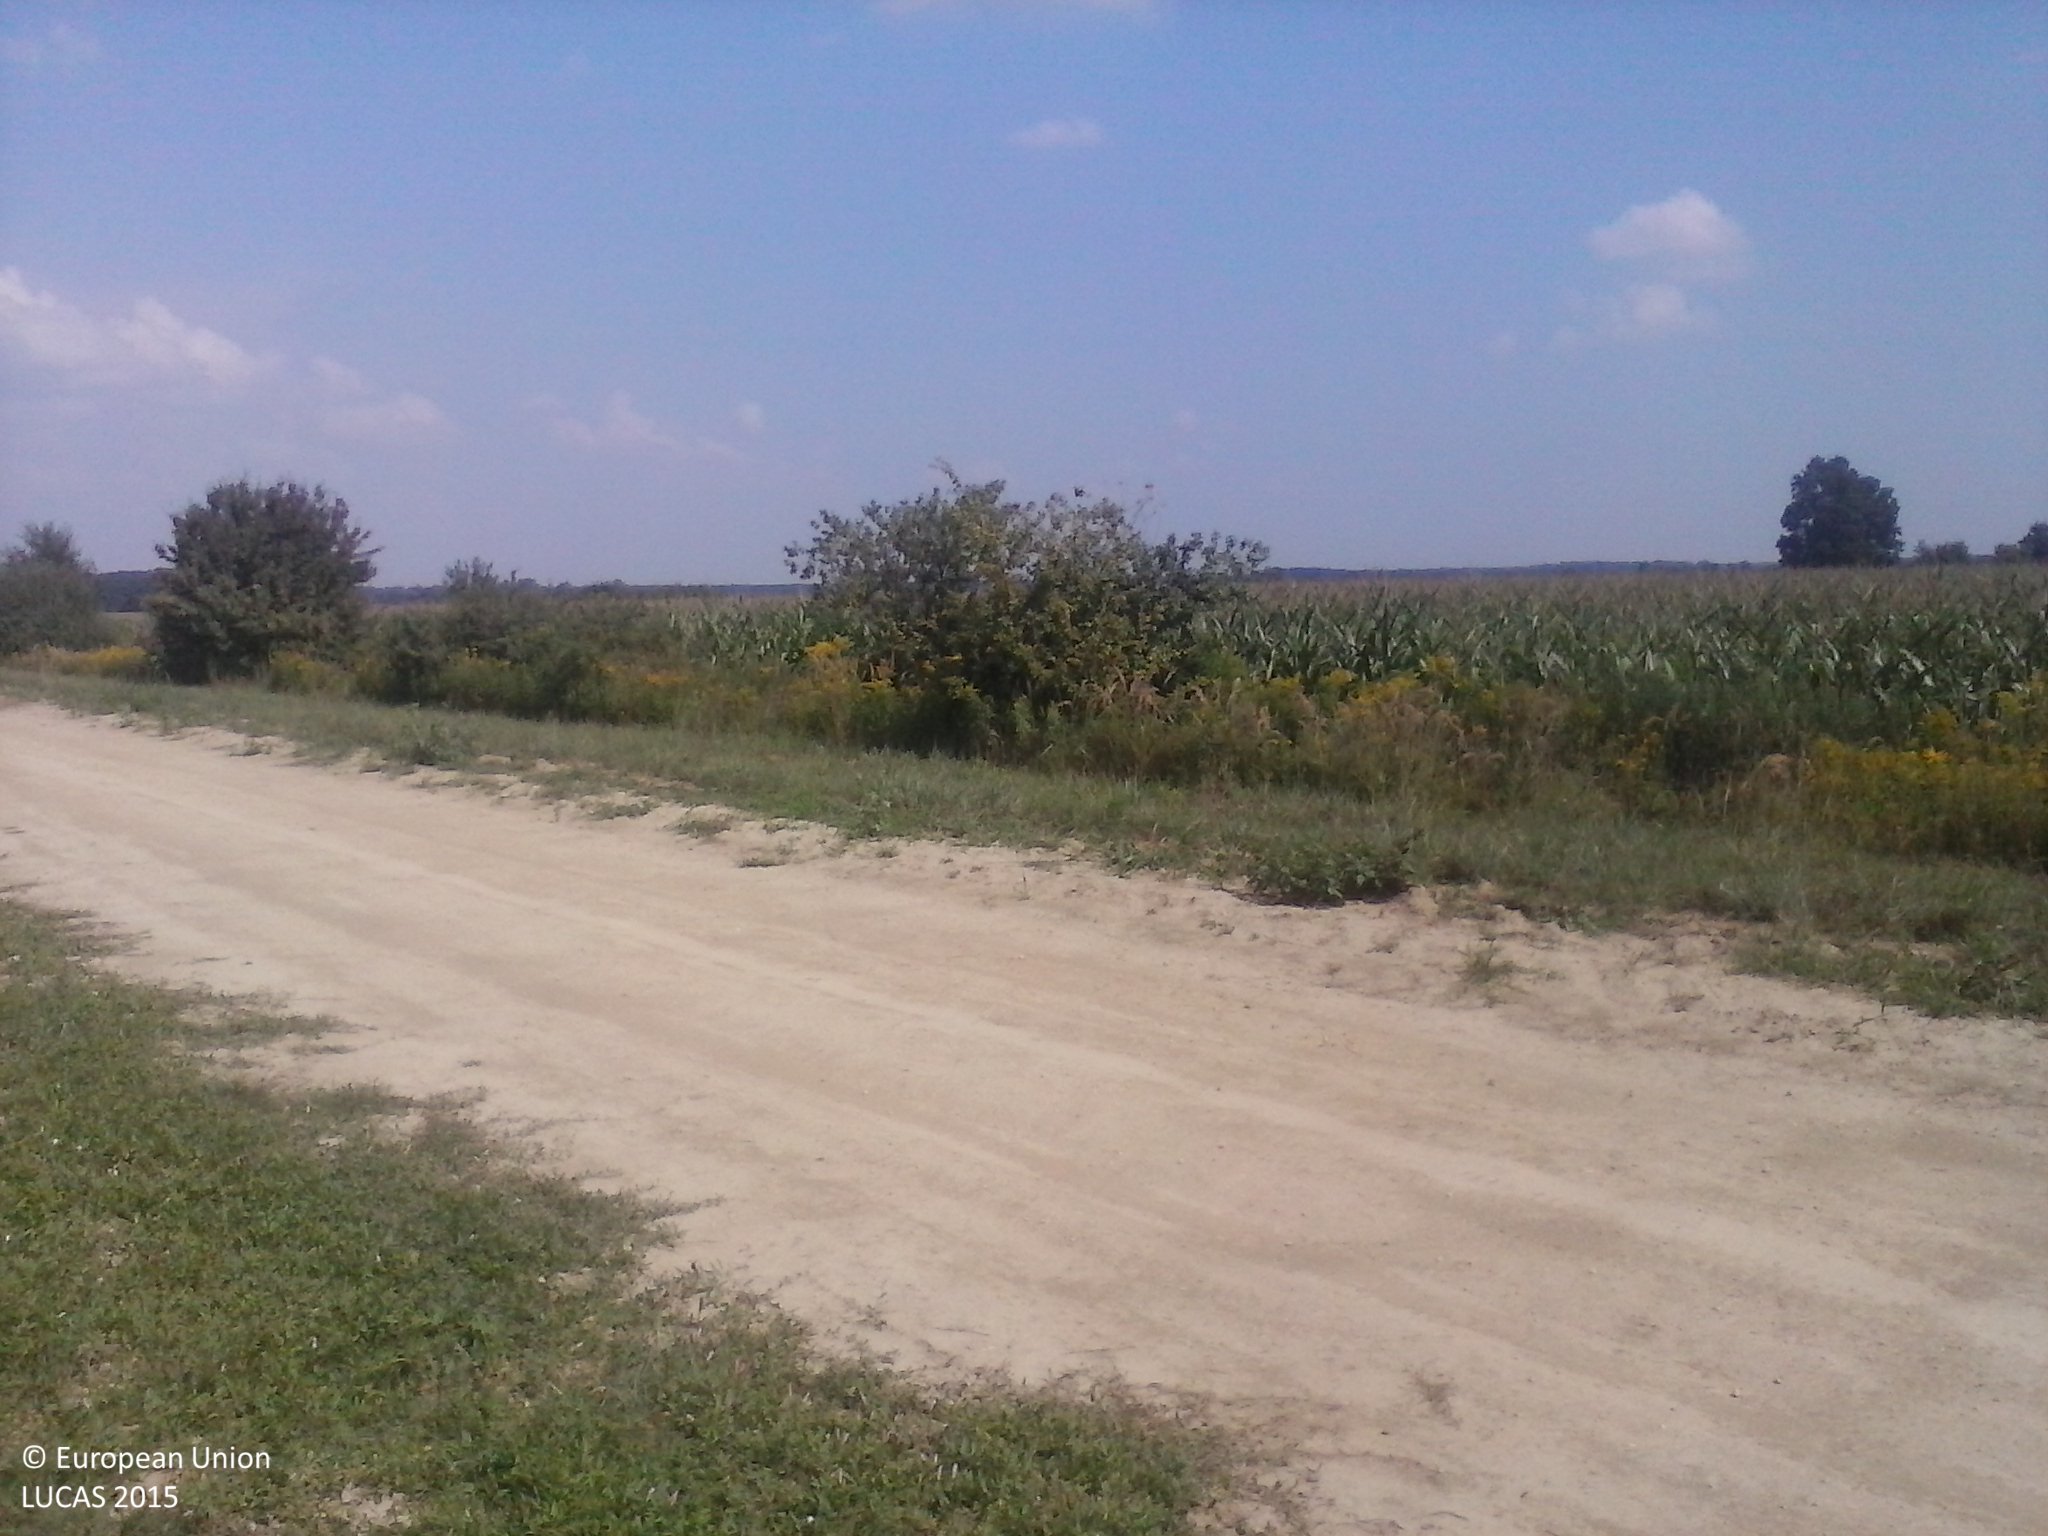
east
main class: Cropland
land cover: Maize
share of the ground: > 75 %
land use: Agriculture (excluding fallow land and kitchen gardens)
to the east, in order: Maize; Grass margins; Ditches and canals; Grass margins; Maize
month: August
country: HU
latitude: 45.9587
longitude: 17.7848
